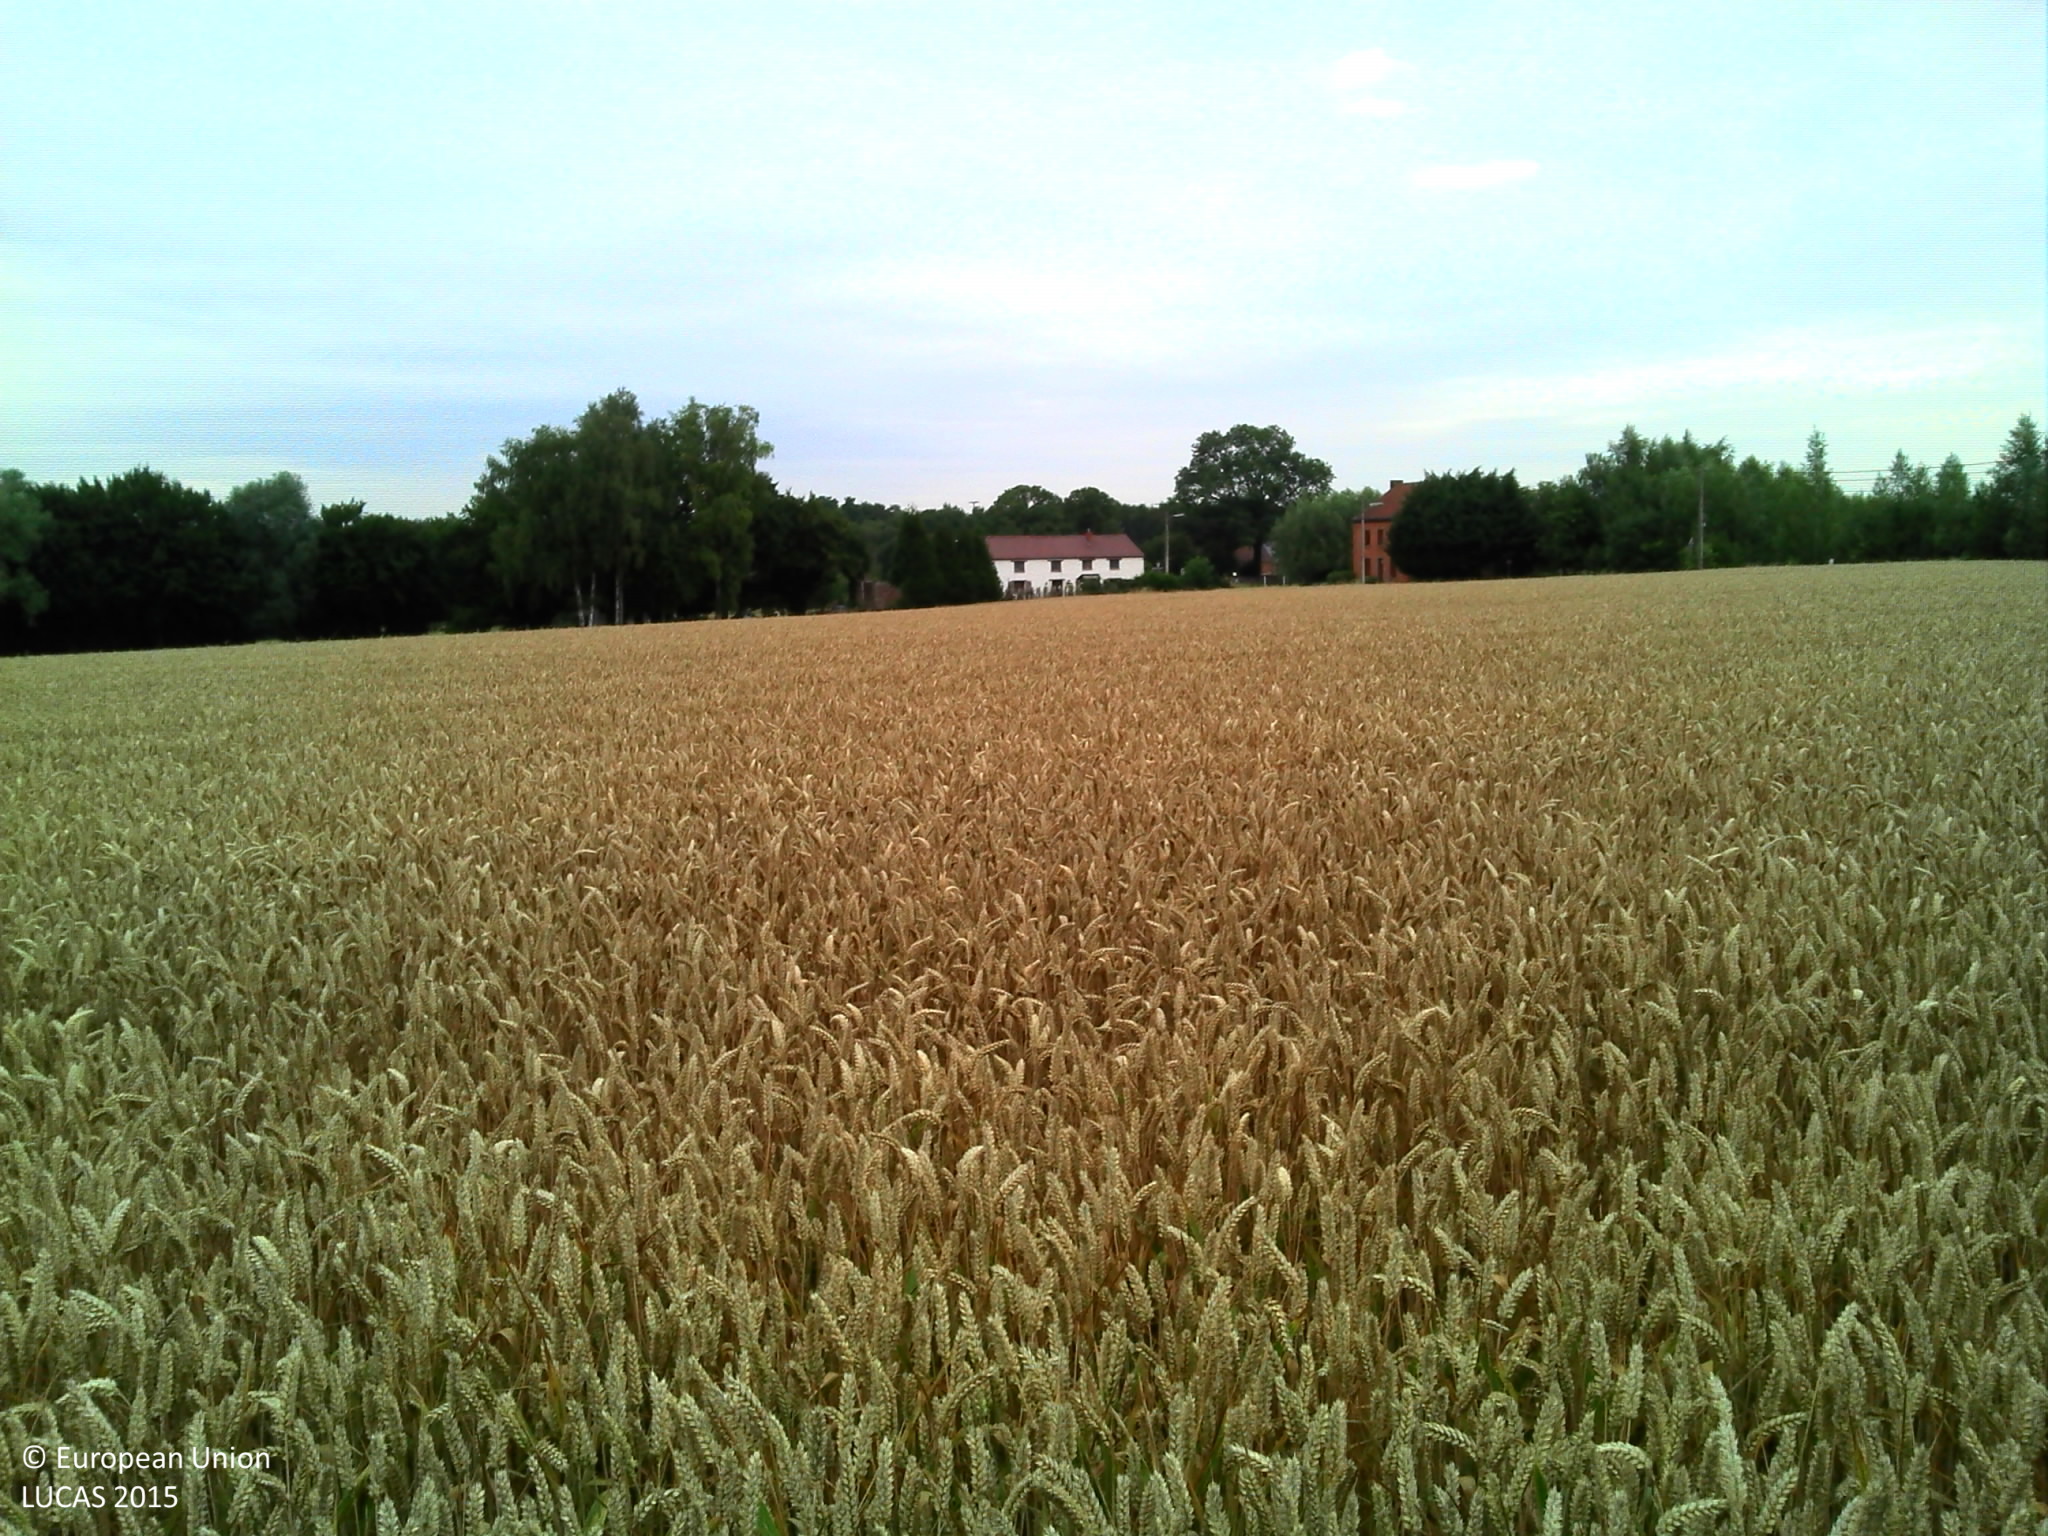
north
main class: Cropland
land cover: Common wheat
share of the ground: > 75 %
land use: Agriculture (excluding fallow land and kitchen gardens)
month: July
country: BE
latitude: 50.5039
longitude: 4.1717
